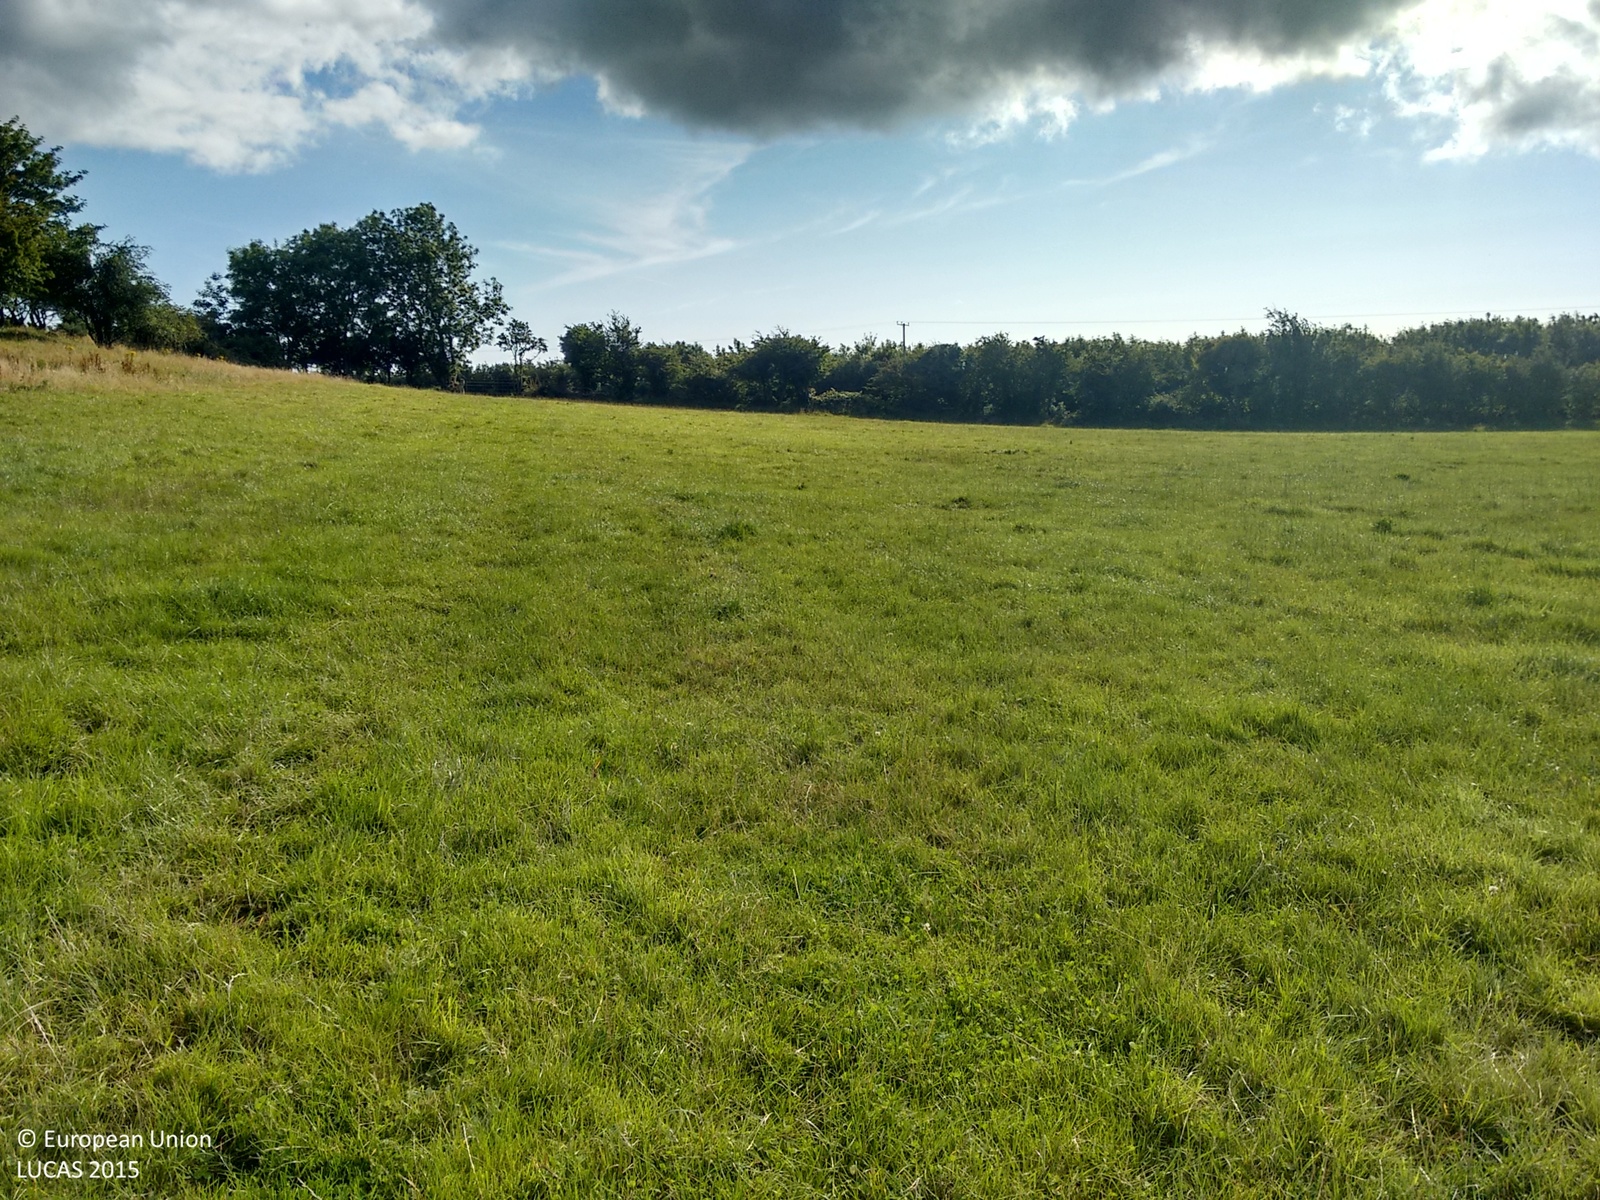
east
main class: Grassland
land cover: Grassland without tree/shrub cover
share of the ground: > 75 %
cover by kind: herbaceous plants 100 %
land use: Agriculture (excluding fallow land and kitchen gardens)
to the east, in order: Grassland without tree/shrub cover; Managed hedges; Grassland without tree/shrub cover; Electric lines; Grassland without tree/shrub cover; Fences; Managed hedges; Other mixed woodland; Paved roads, cycling and walking lanes; Other mixed woodland; Artificial constructions in urban areas
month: August
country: IE
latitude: 53.7785
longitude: -6.4063
